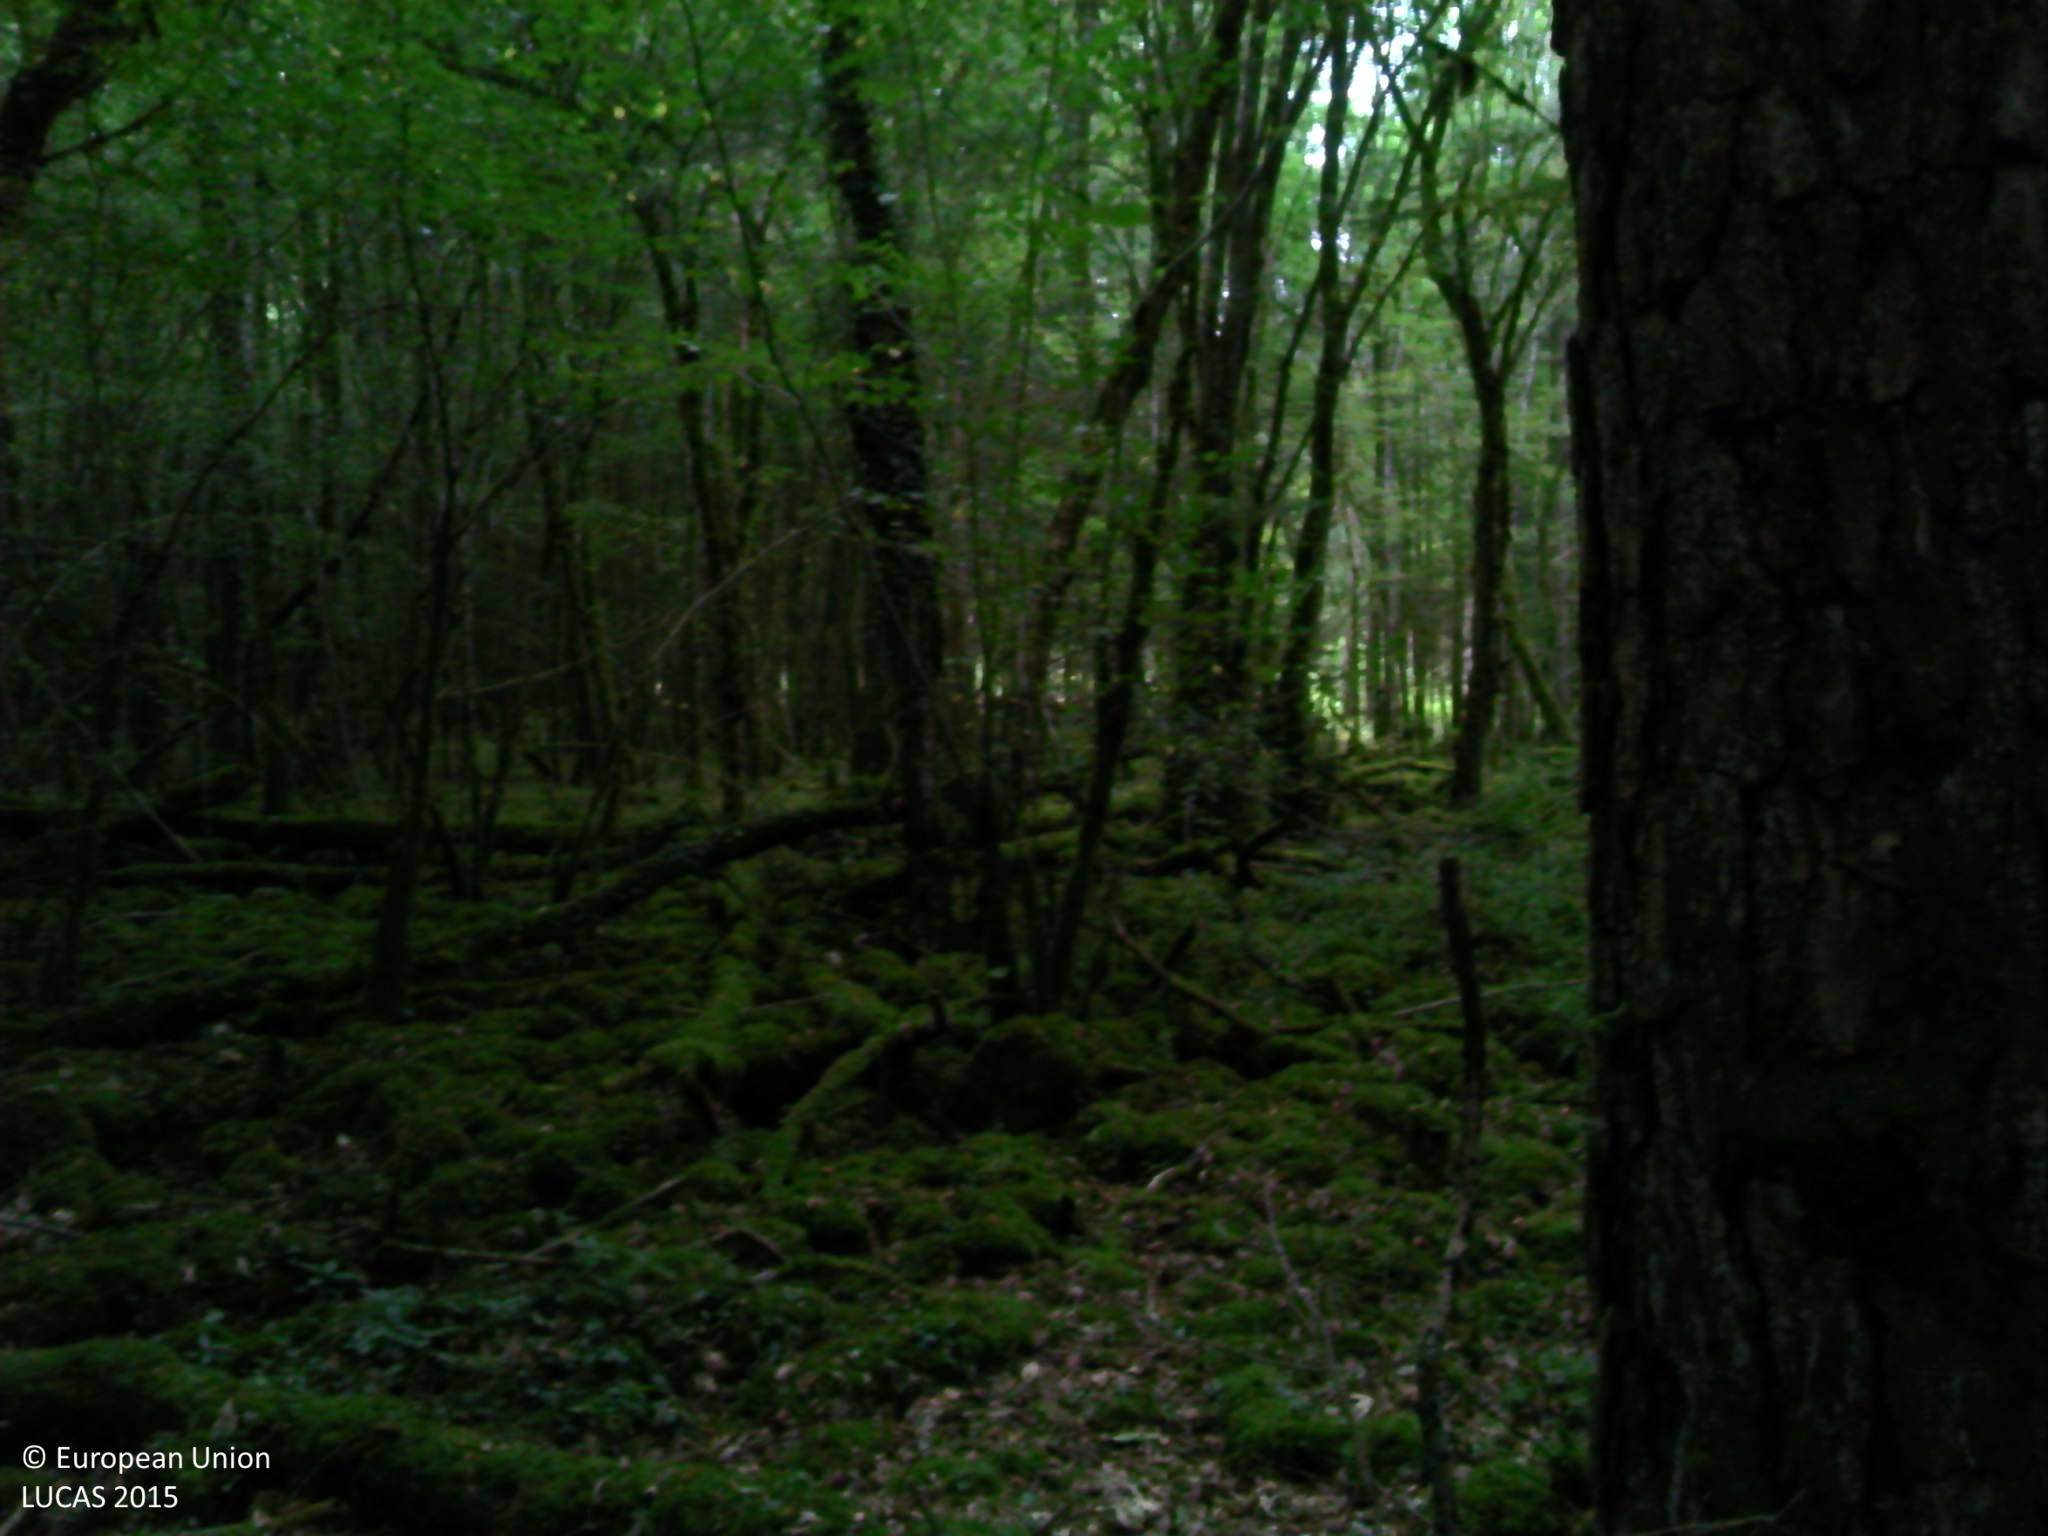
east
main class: Woodland
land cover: Pine dominated mixed woodland
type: hemiboreal forest and nemoral coniferous forest and mixed broadleaved-coniferous forest
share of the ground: > 75 %
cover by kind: coniferous forest trees 45 %, broadleaved forest trees 45 %, herbaceous plants 5 %, lichens and mosses 5 %
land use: Forestry
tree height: > 5 m
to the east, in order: Pine dominated mixed woodland; Rock outcrops; Pine dominated mixed woodland; Spruce dominated mixed woodland; Spruce dominated coniferous woodland; Dry stone walls; Broadleaved woodland; Dry stone walls; Broadleaved woodland; Dry stone walls; Broadleaved woodland; Tracks; Dry stone walls; Spruce dominated mixed woodland; Barley
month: August
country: FR
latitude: 47.7510
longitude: 4.6501
